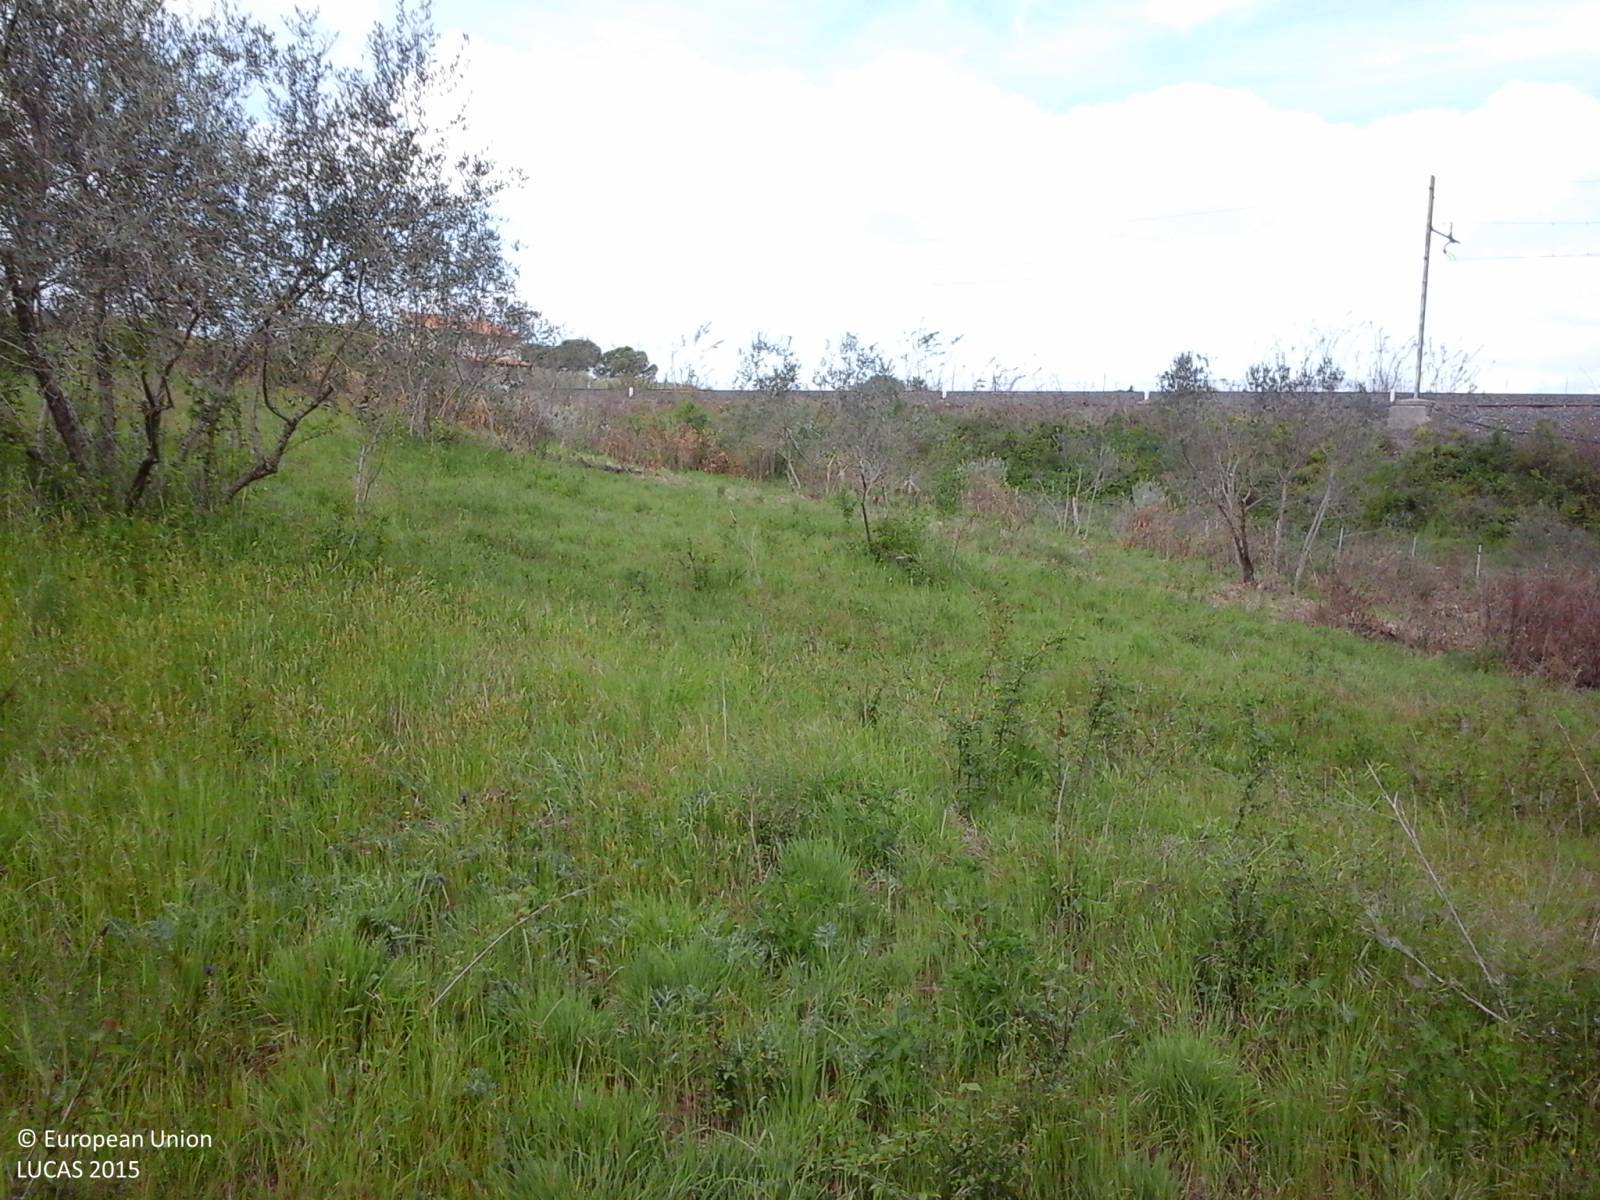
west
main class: Cropland
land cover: Olive groves
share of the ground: 25 - 50 %
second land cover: Grassland without tree/shrub cover
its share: > 75 %
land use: Agriculture (excluding fallow land and kitchen gardens)
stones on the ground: < 10 %
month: May
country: IT
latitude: 42.3614
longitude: 12.0933
